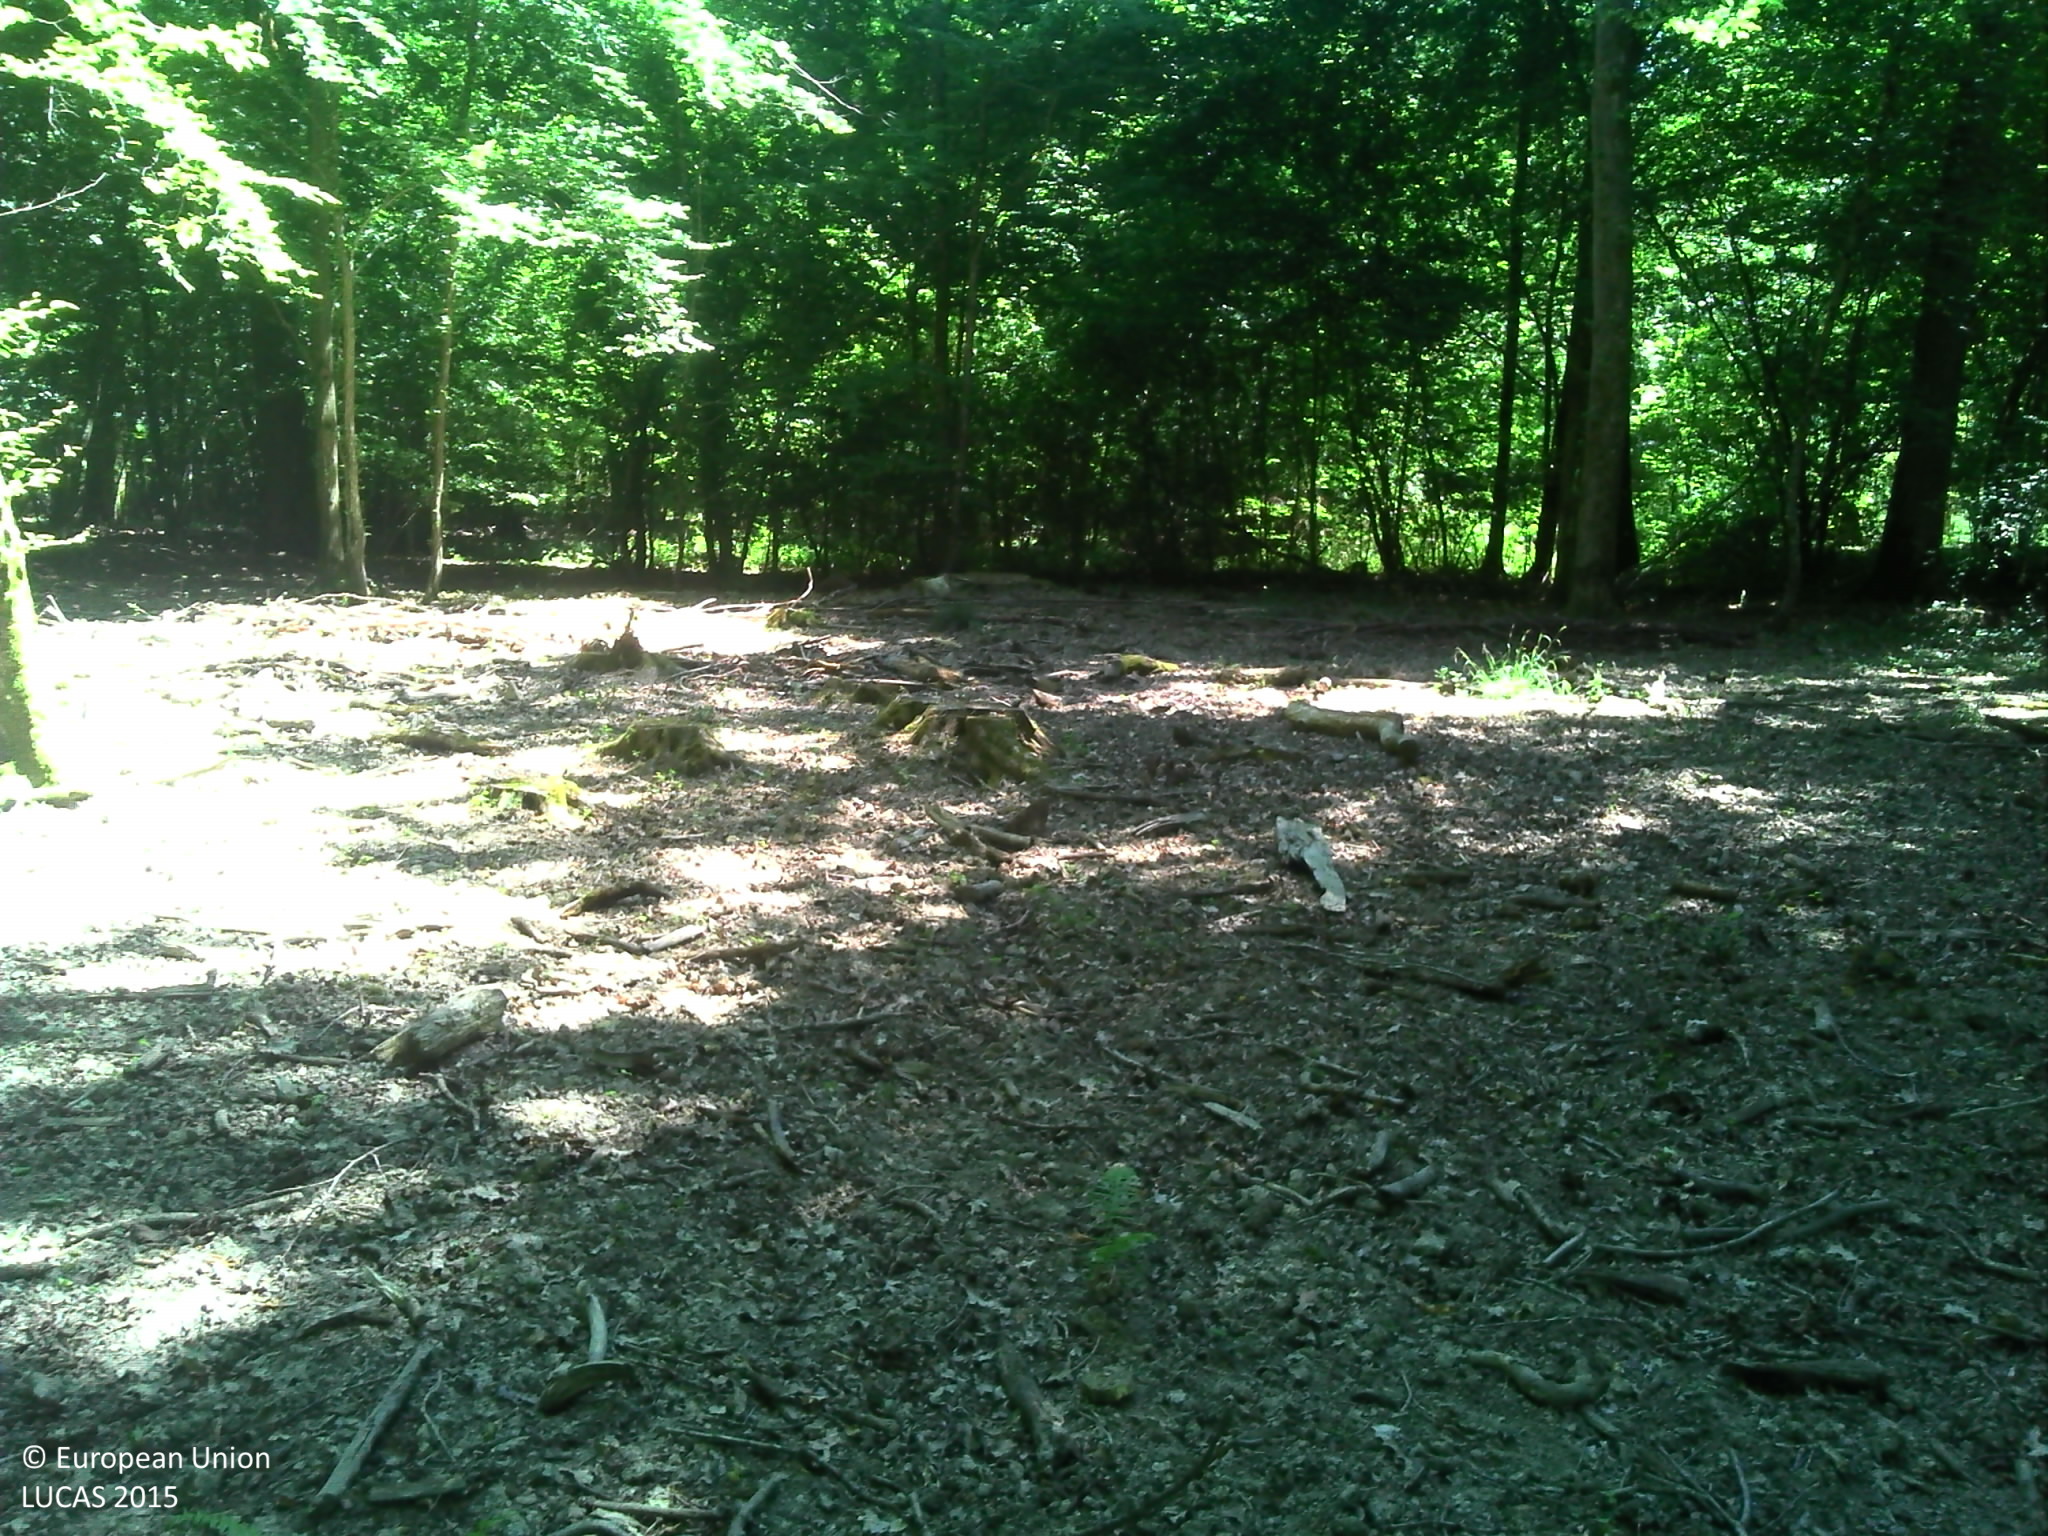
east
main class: Woodland
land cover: Broadleaved woodland
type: mesophytic deciduous forest
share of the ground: > 75 %
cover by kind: broadleaved forest trees 90 %, herbaceous plants 5 %, consolidated bare surface 5 %
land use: Forestry
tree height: > 5 m
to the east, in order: Broadleaved woodland
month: June
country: FR
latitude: 48.9283
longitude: 3.4004
